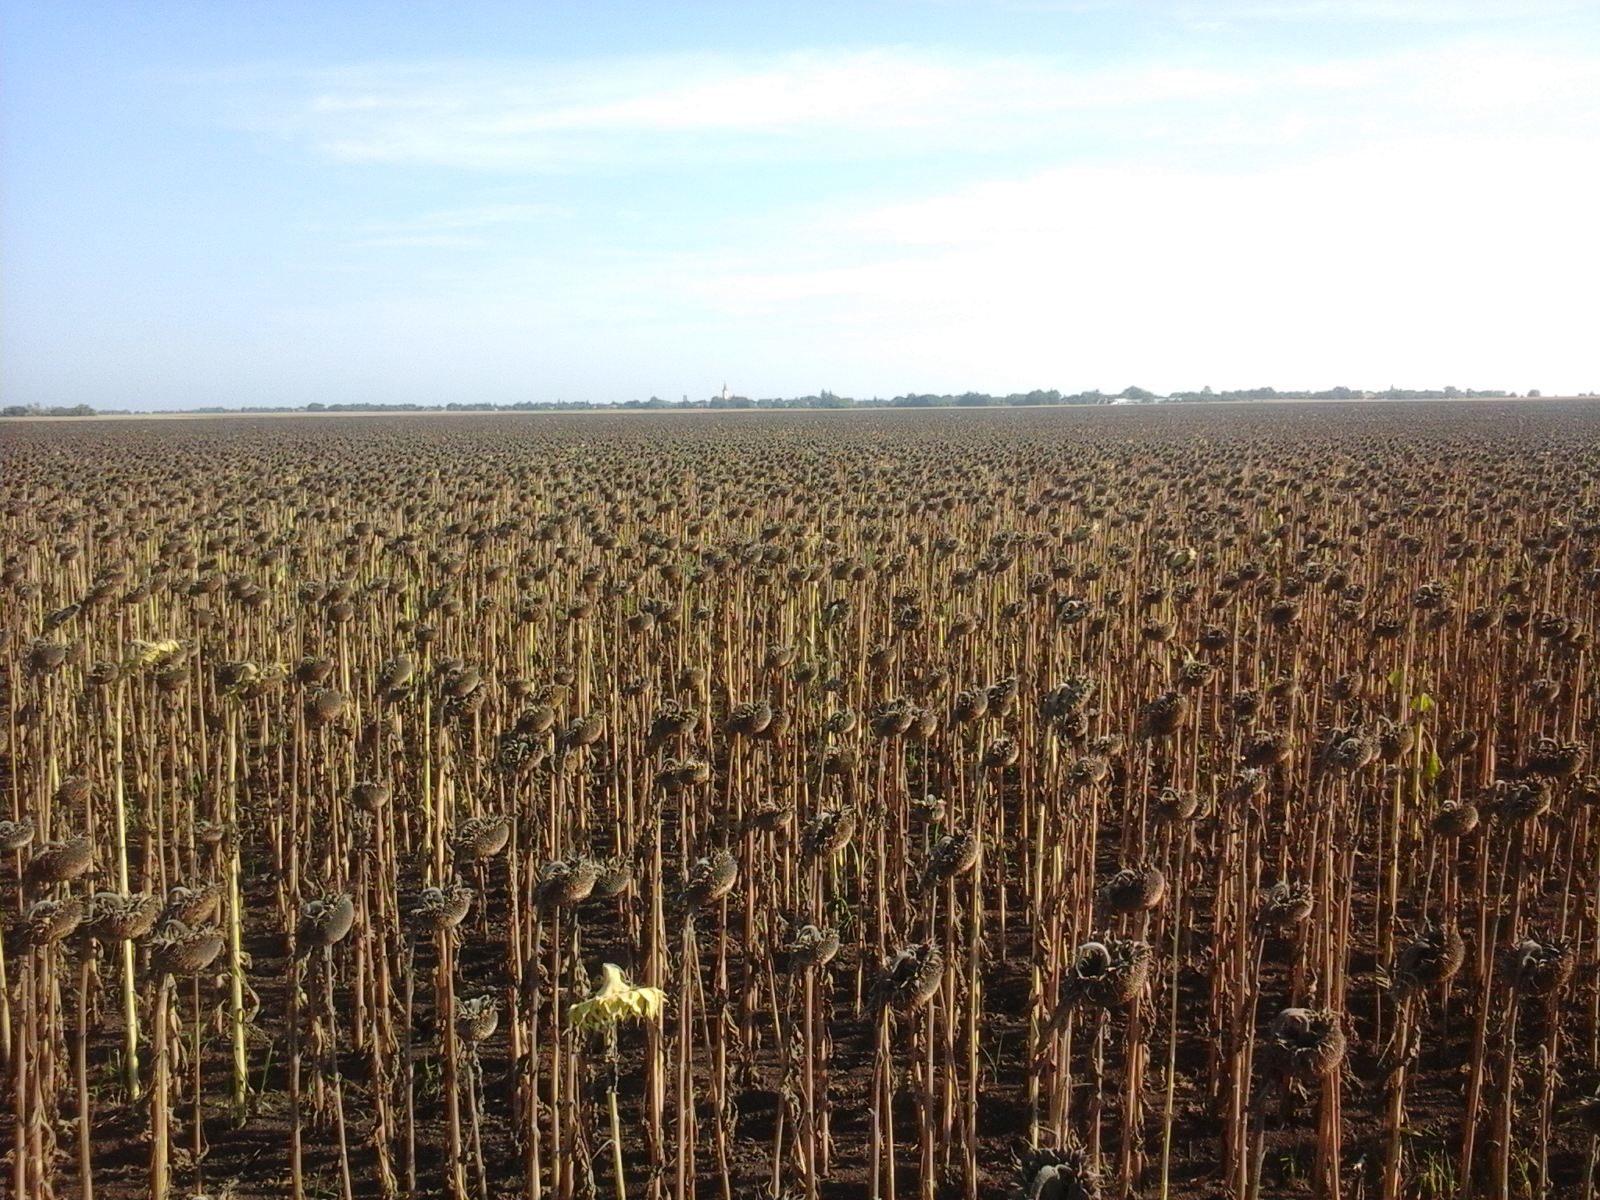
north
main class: Cropland
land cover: Sunflower
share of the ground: > 75 %
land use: Agriculture (excluding fallow land and kitchen gardens)
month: August
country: RO
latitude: 46.0258
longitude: 21.1017
